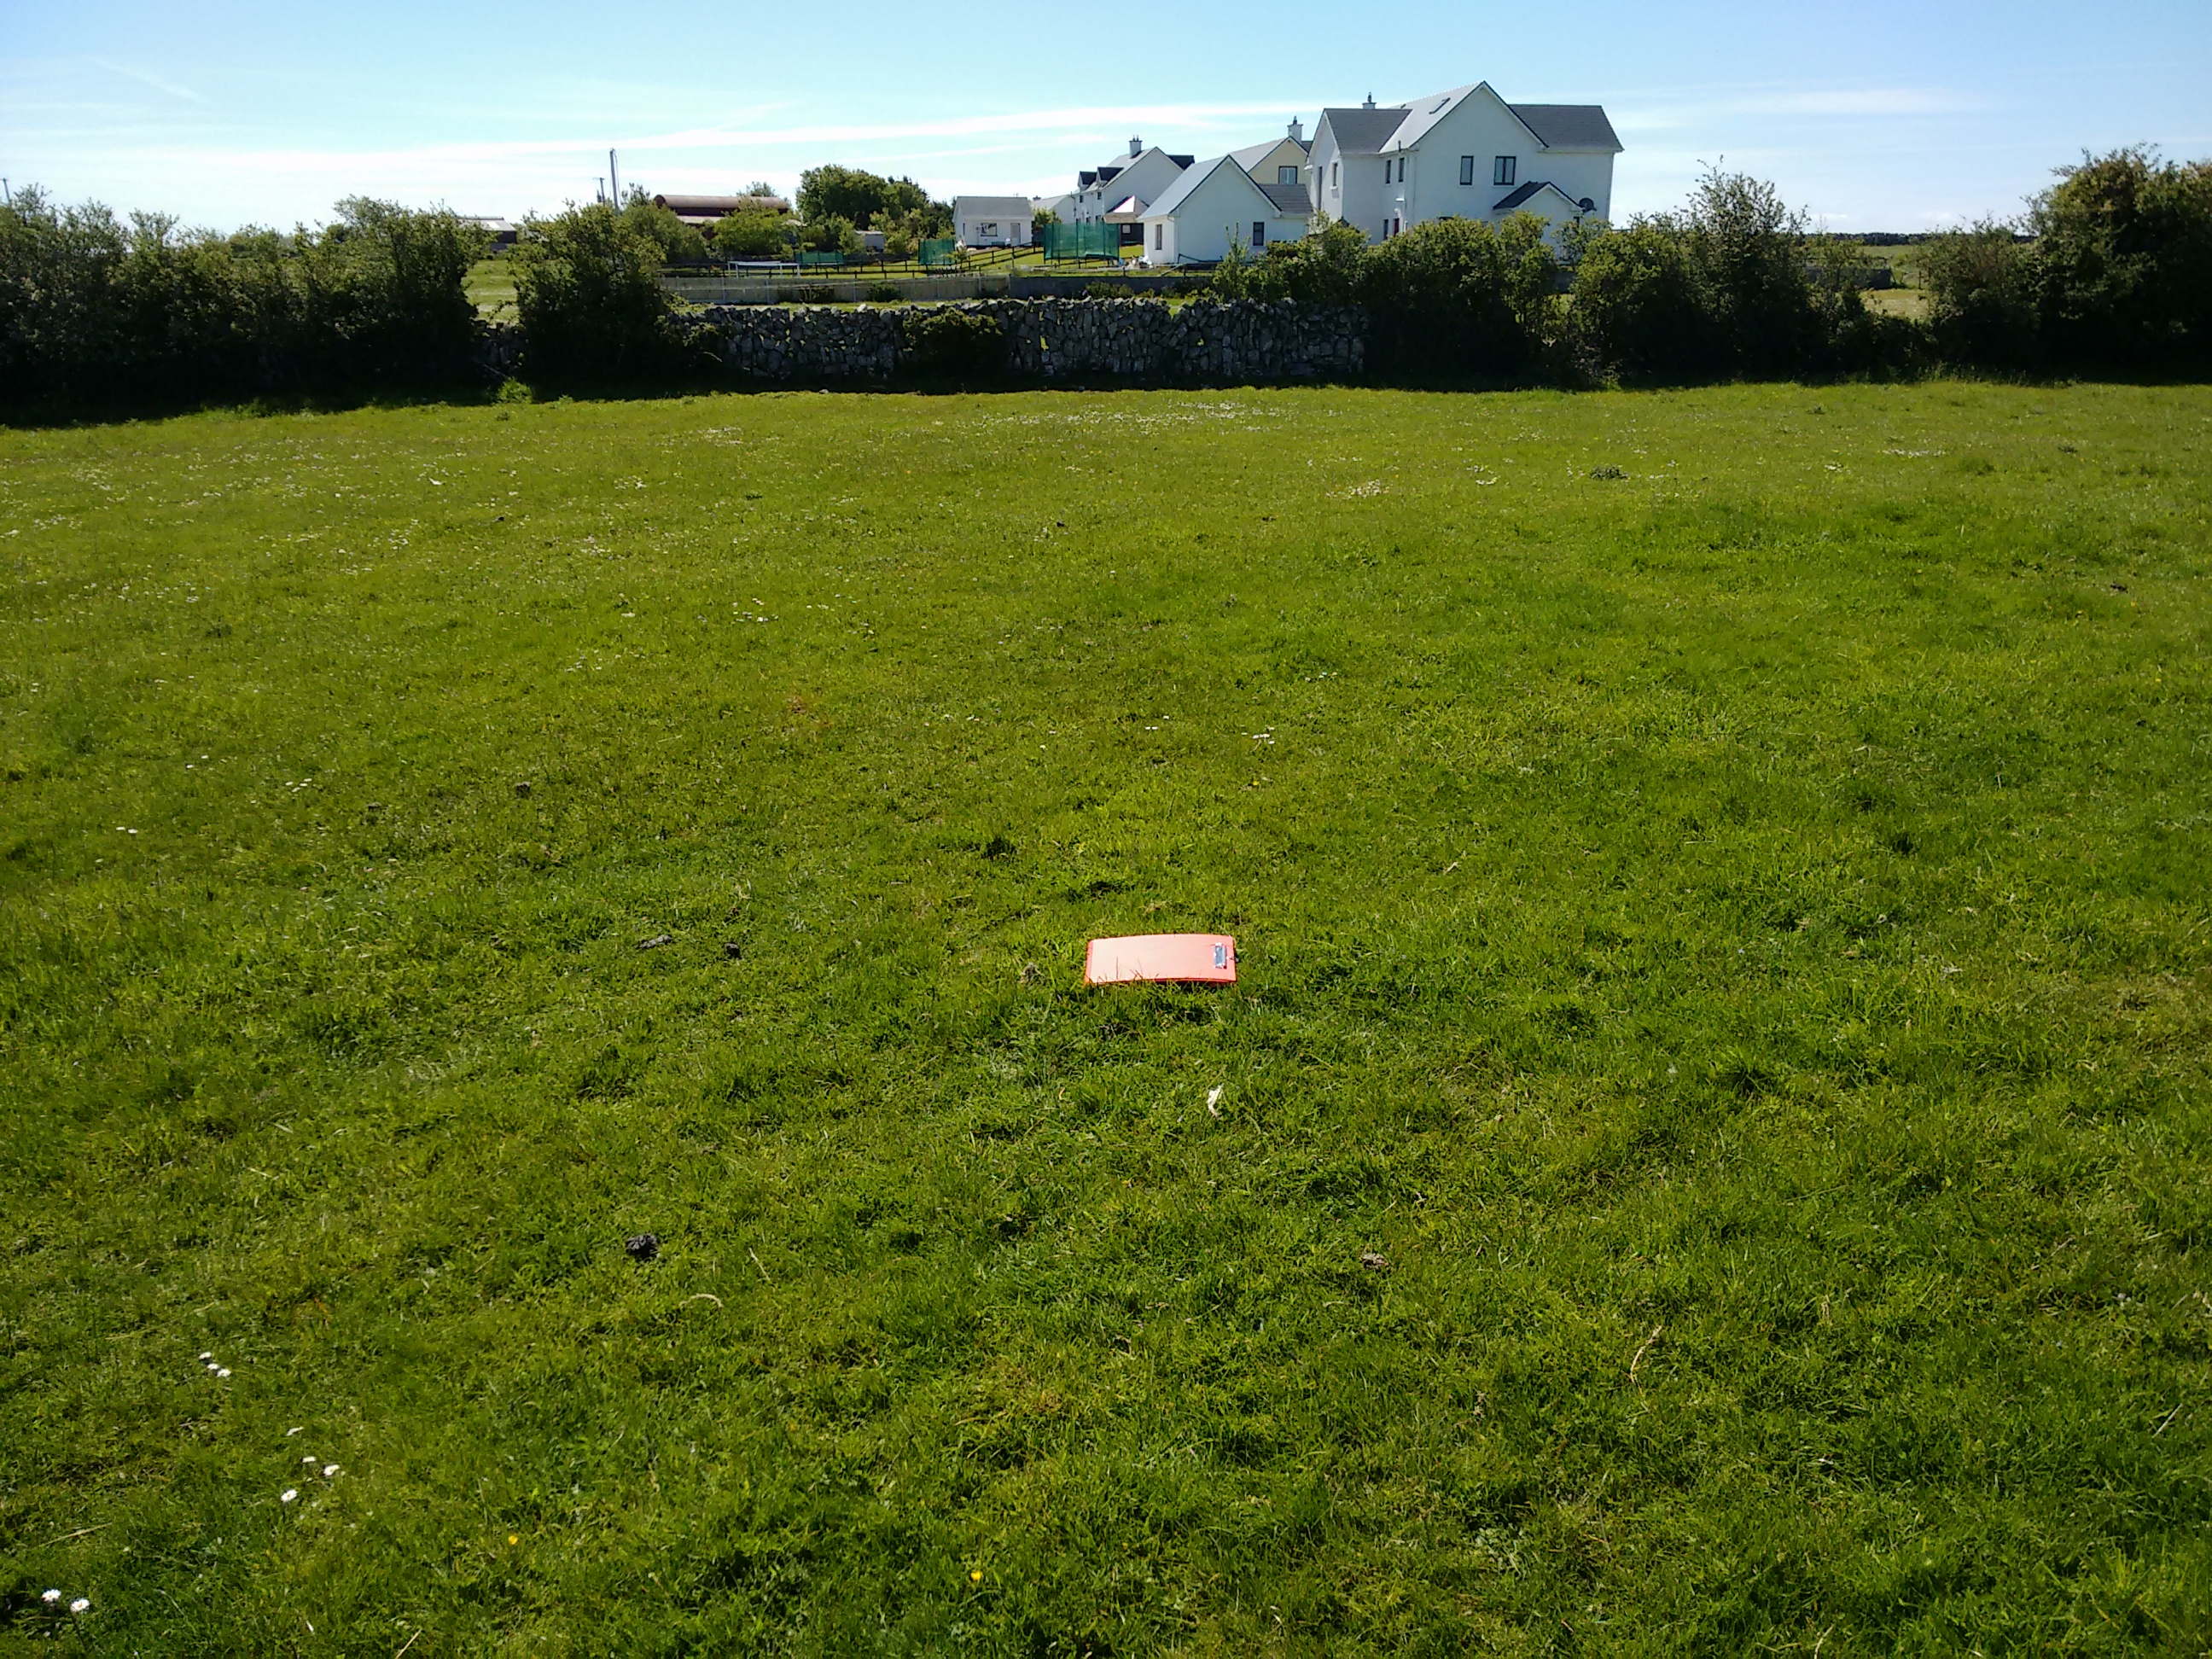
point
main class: Grassland
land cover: Grassland without tree/shrub cover
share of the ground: > 75 %
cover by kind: herbaceous plants 100 %
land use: Agriculture (excluding fallow land and kitchen gardens)
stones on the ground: < 10 %
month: June
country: IE
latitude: 53.1753
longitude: -8.8642
